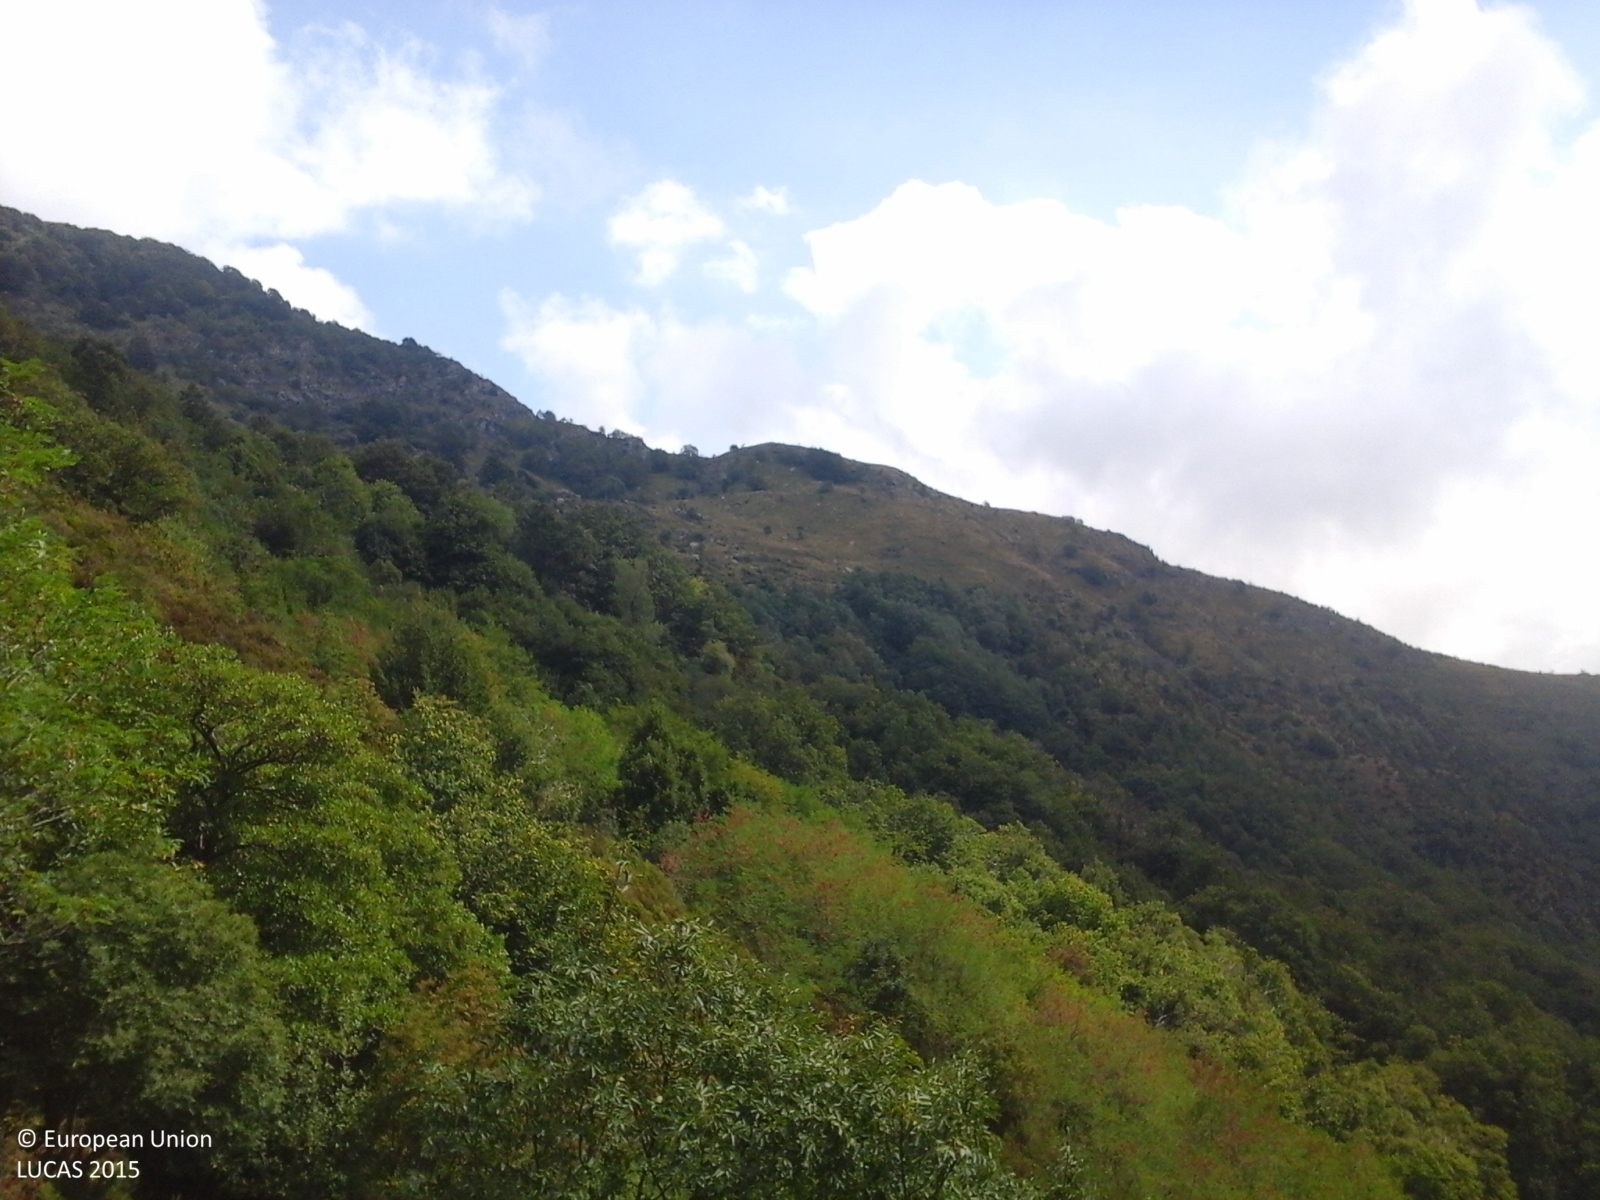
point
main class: Woodland
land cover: Broadleaved woodland
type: thermophilous deciduous forest
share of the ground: > 75 %
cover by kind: broadleaved forest trees 100 %
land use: Forestry
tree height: > 5 m
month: September
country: IT
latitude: 44.4558
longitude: 9.2100
